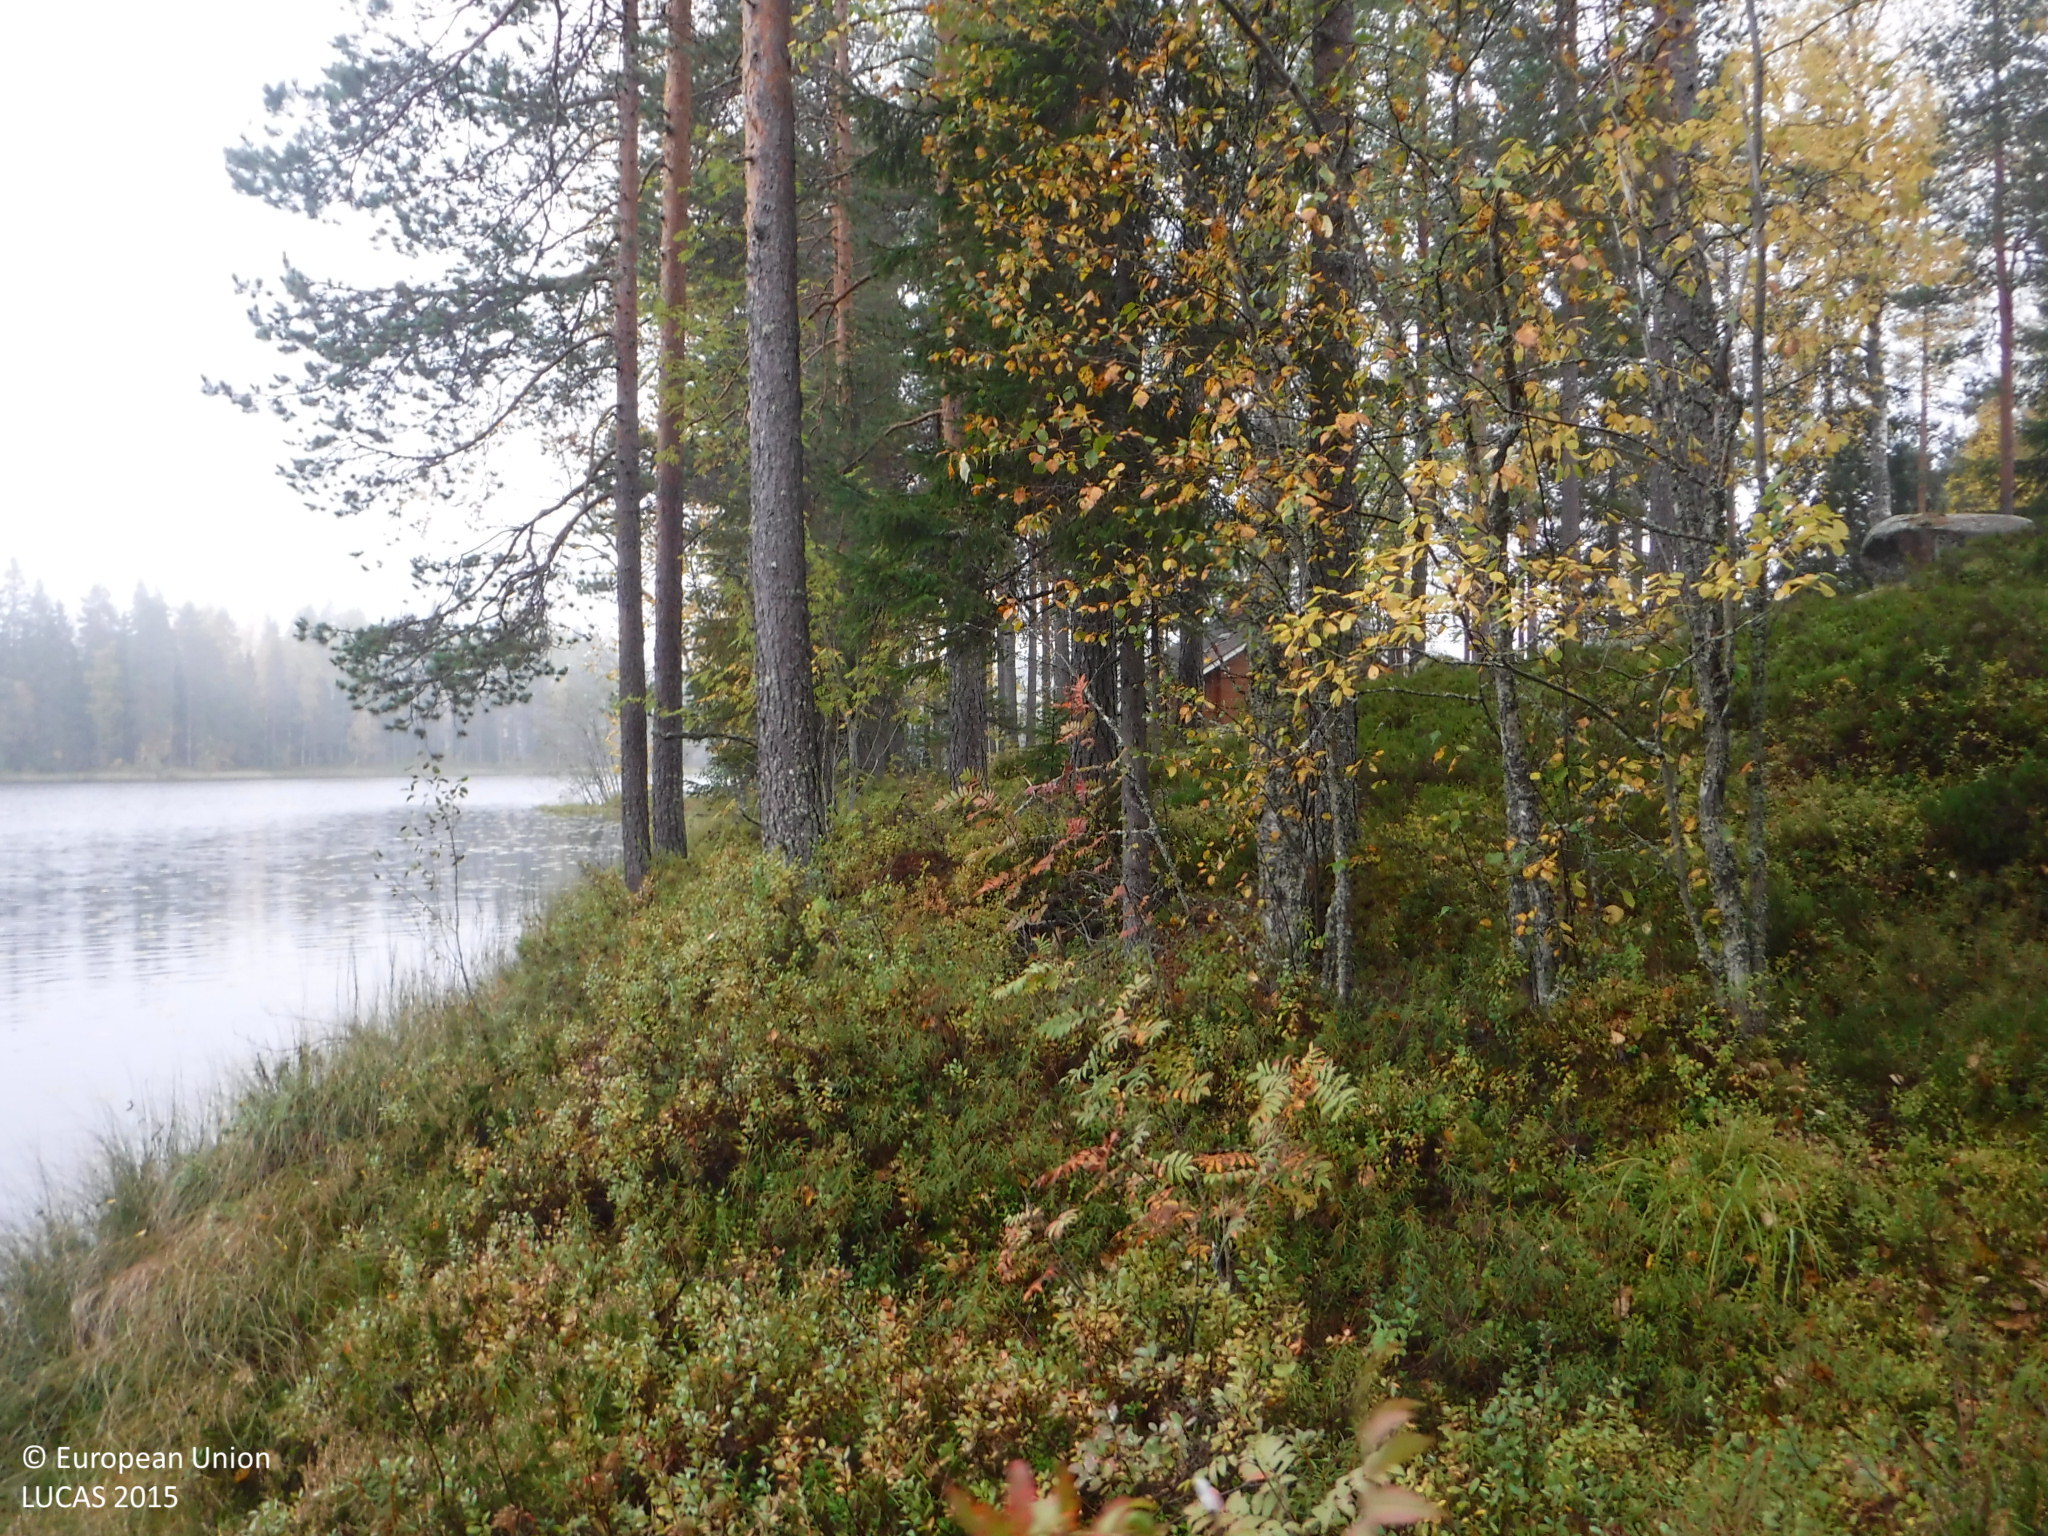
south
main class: Woodland
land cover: Other coniferous woodland
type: boreal forest
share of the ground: 50 - 75 %
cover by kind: coniferous forest trees 60 %, shrubs 30 %, broadleaved forest trees 5 %, lichens and mosses 5 %
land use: Forestry
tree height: > 5 m
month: September
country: FI
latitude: 61.8036
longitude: 24.2244
